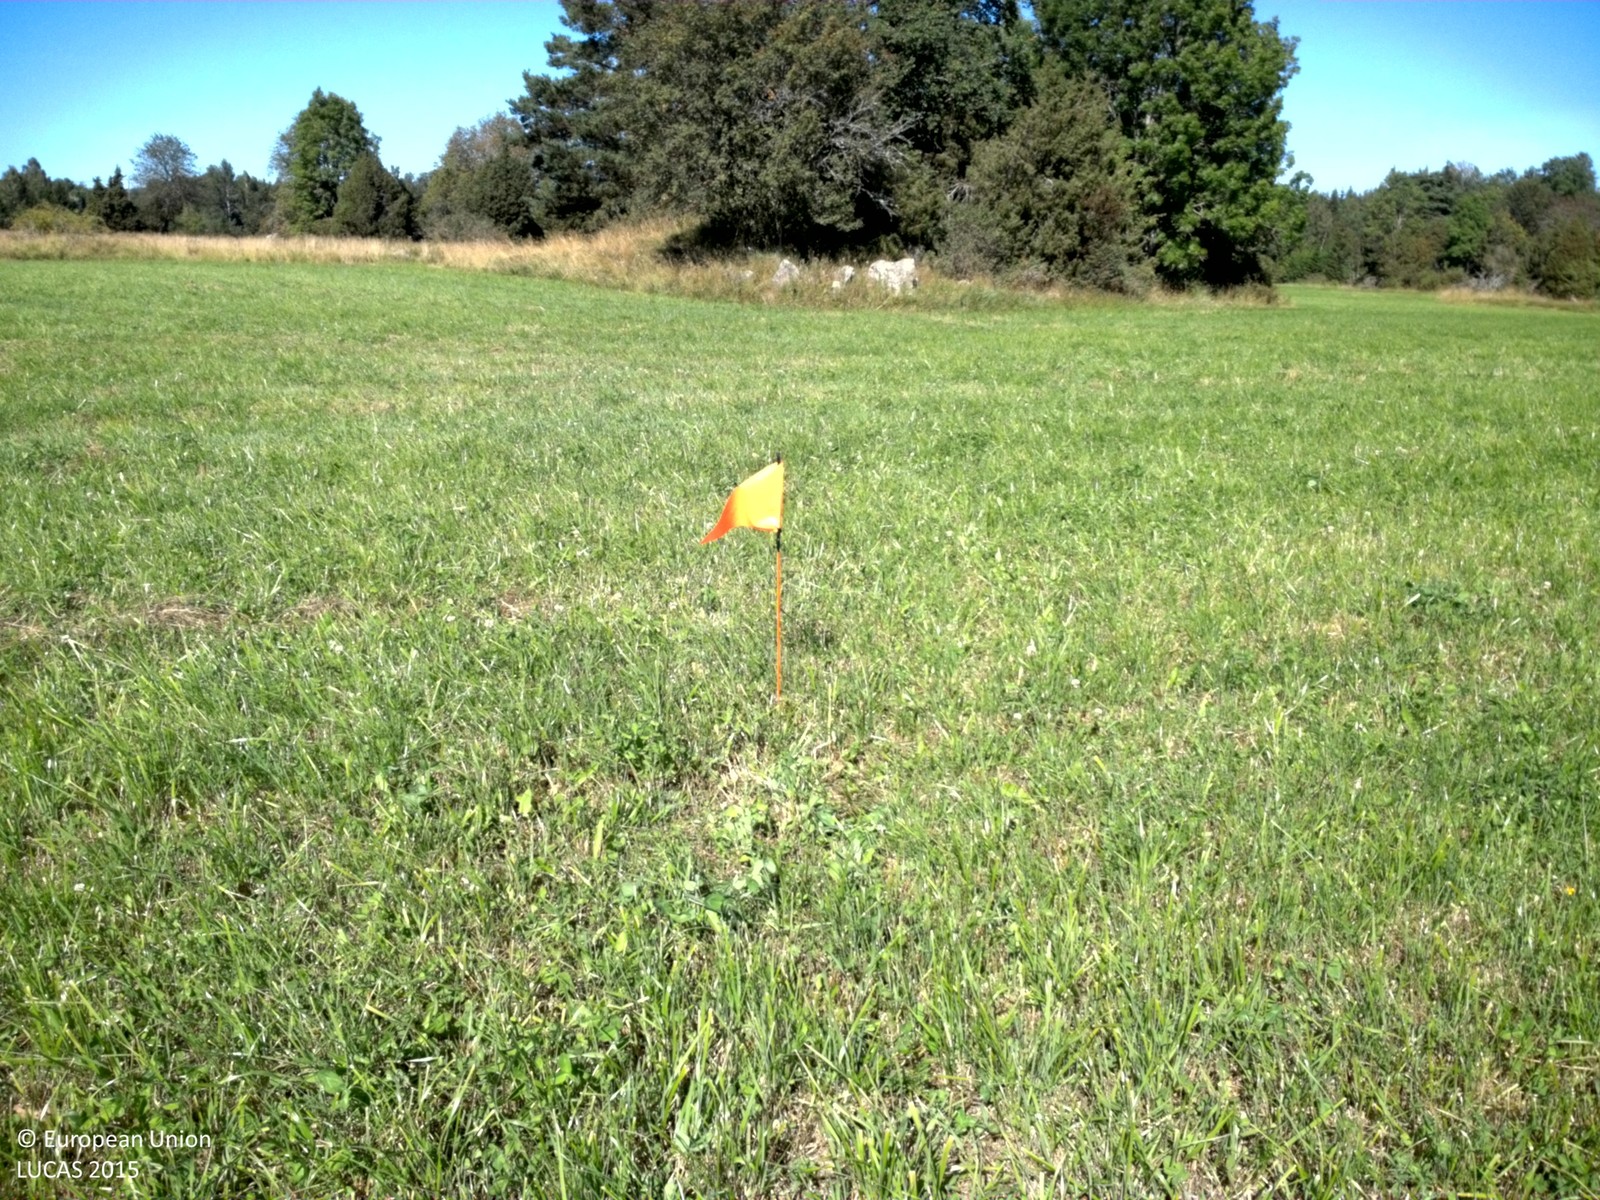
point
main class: Cropland
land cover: Other leguminous and mixtures for fodder
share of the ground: > 75 %
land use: Agriculture (excluding fallow land and kitchen gardens)
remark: Harvested field
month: August
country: SE
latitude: 59.9912
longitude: 17.9719
